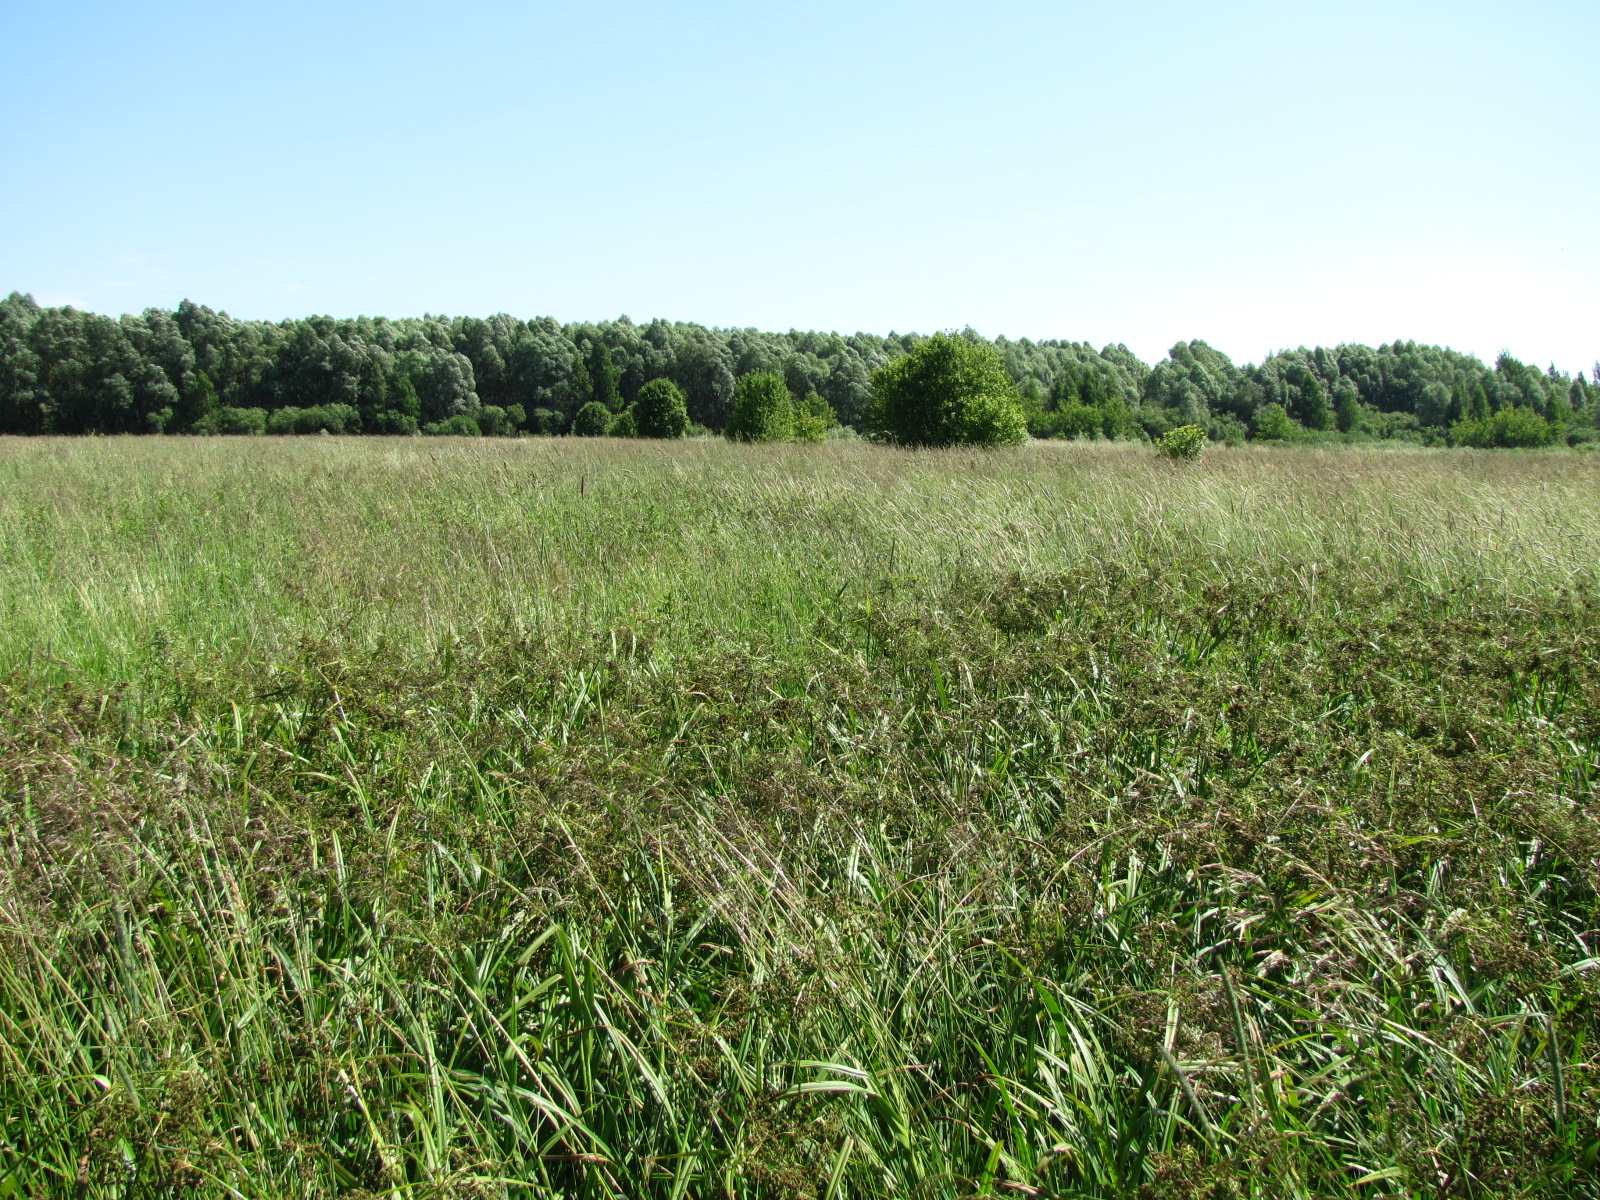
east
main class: Grassland
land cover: Grassland without tree/shrub cover
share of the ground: > 75 %
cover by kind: herbaceous plants 100 %
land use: Agriculture (excluding fallow land and kitchen gardens)
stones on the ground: < 10 %
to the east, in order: Grassland without tree/shrub cover; Spontaneously vegetated surfaces; Inland fresh running water; Spontaneously vegetated surfaces; Broadleaved woodland
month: July
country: LV
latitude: 56.8974
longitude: 24.1564
